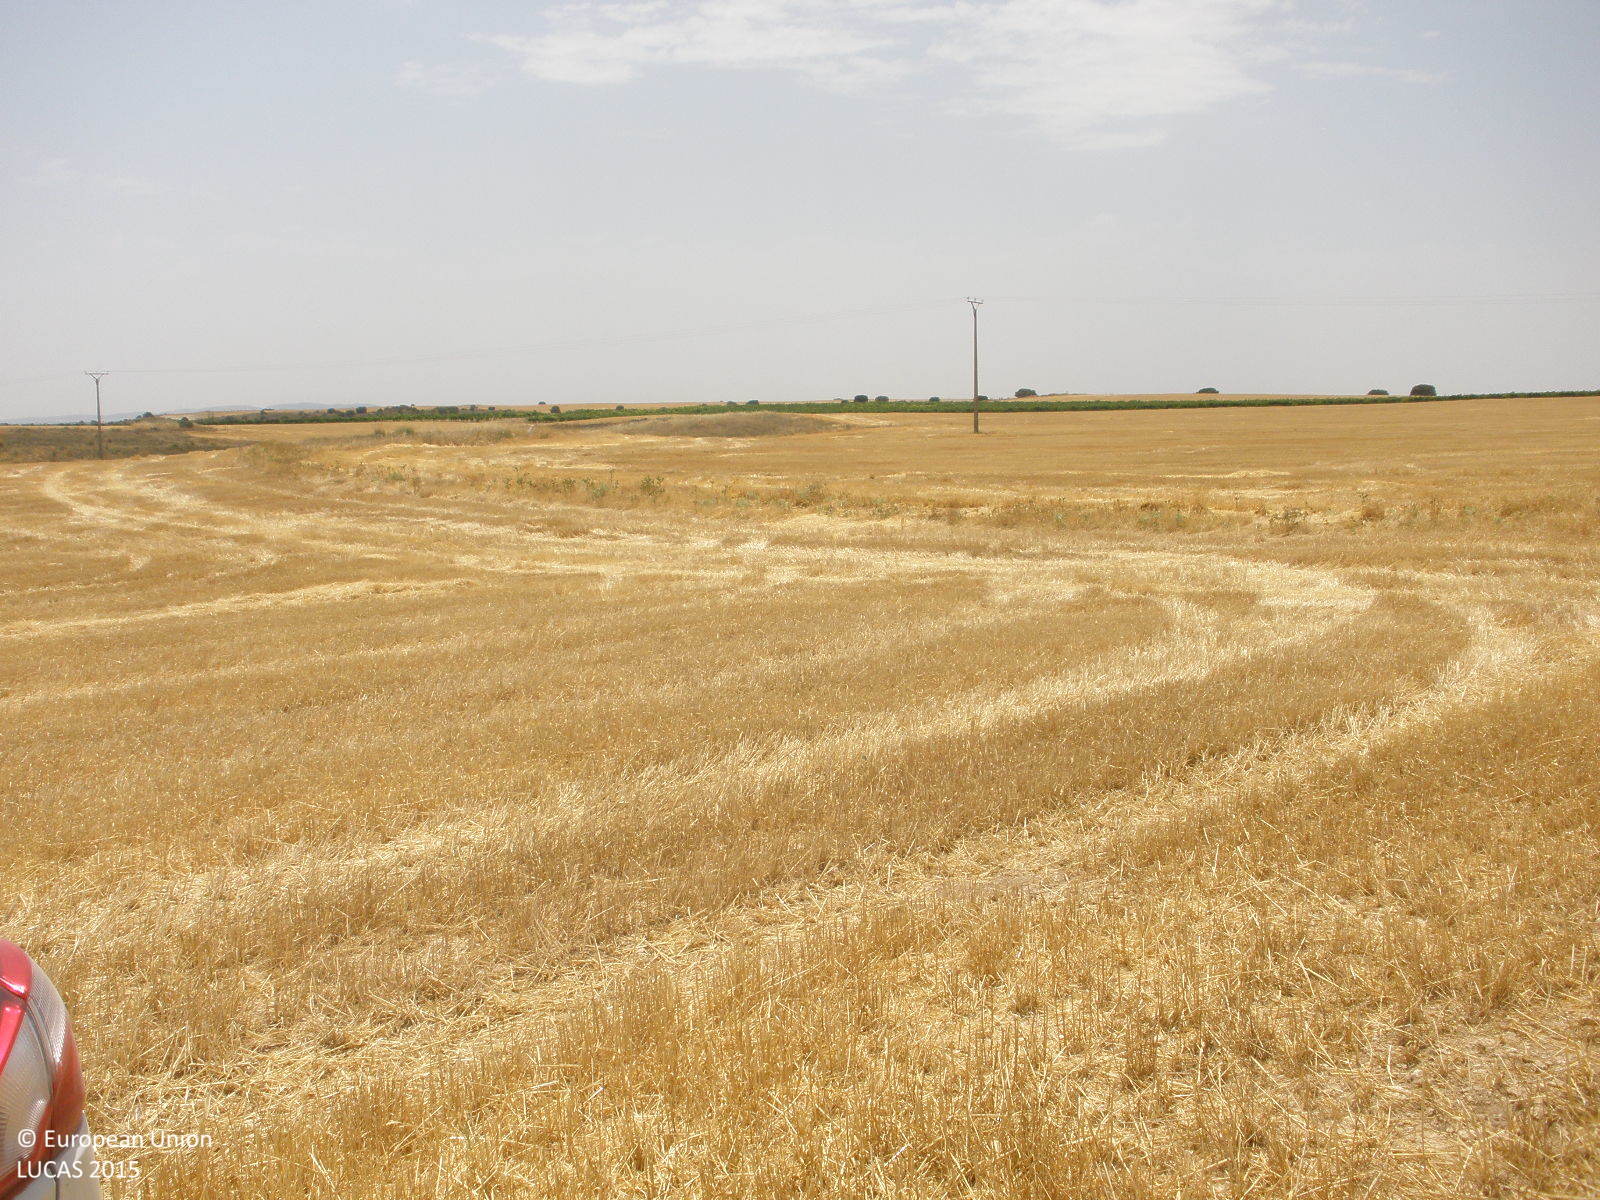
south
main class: Cropland
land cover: Barley
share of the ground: < 10 %
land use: Agriculture (excluding fallow land and kitchen gardens)
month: July
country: ES
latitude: 39.8403
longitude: -3.3831
